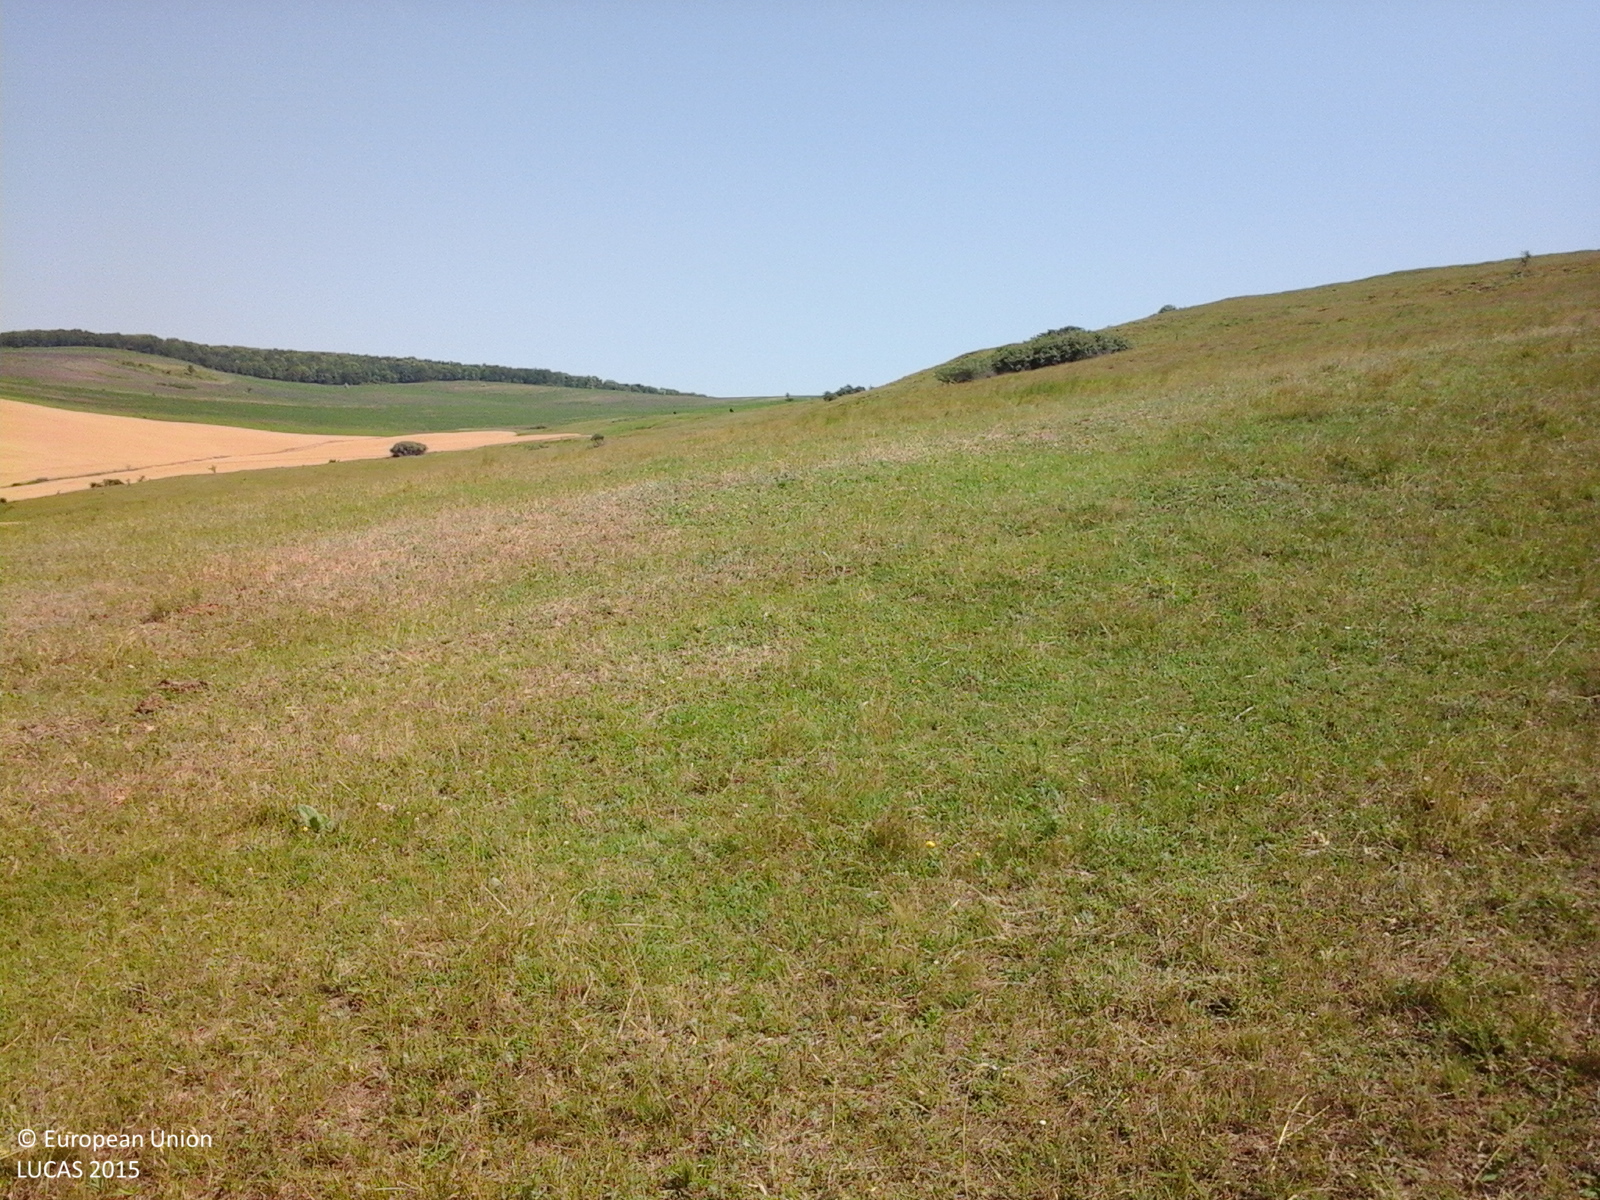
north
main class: Grassland
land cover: Grassland without tree/shrub cover
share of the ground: > 75 %
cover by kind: herbaceous plants 100 %
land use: Agriculture (excluding fallow land and kitchen gardens)
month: June
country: RO
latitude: 46.8445
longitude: 27.9484
